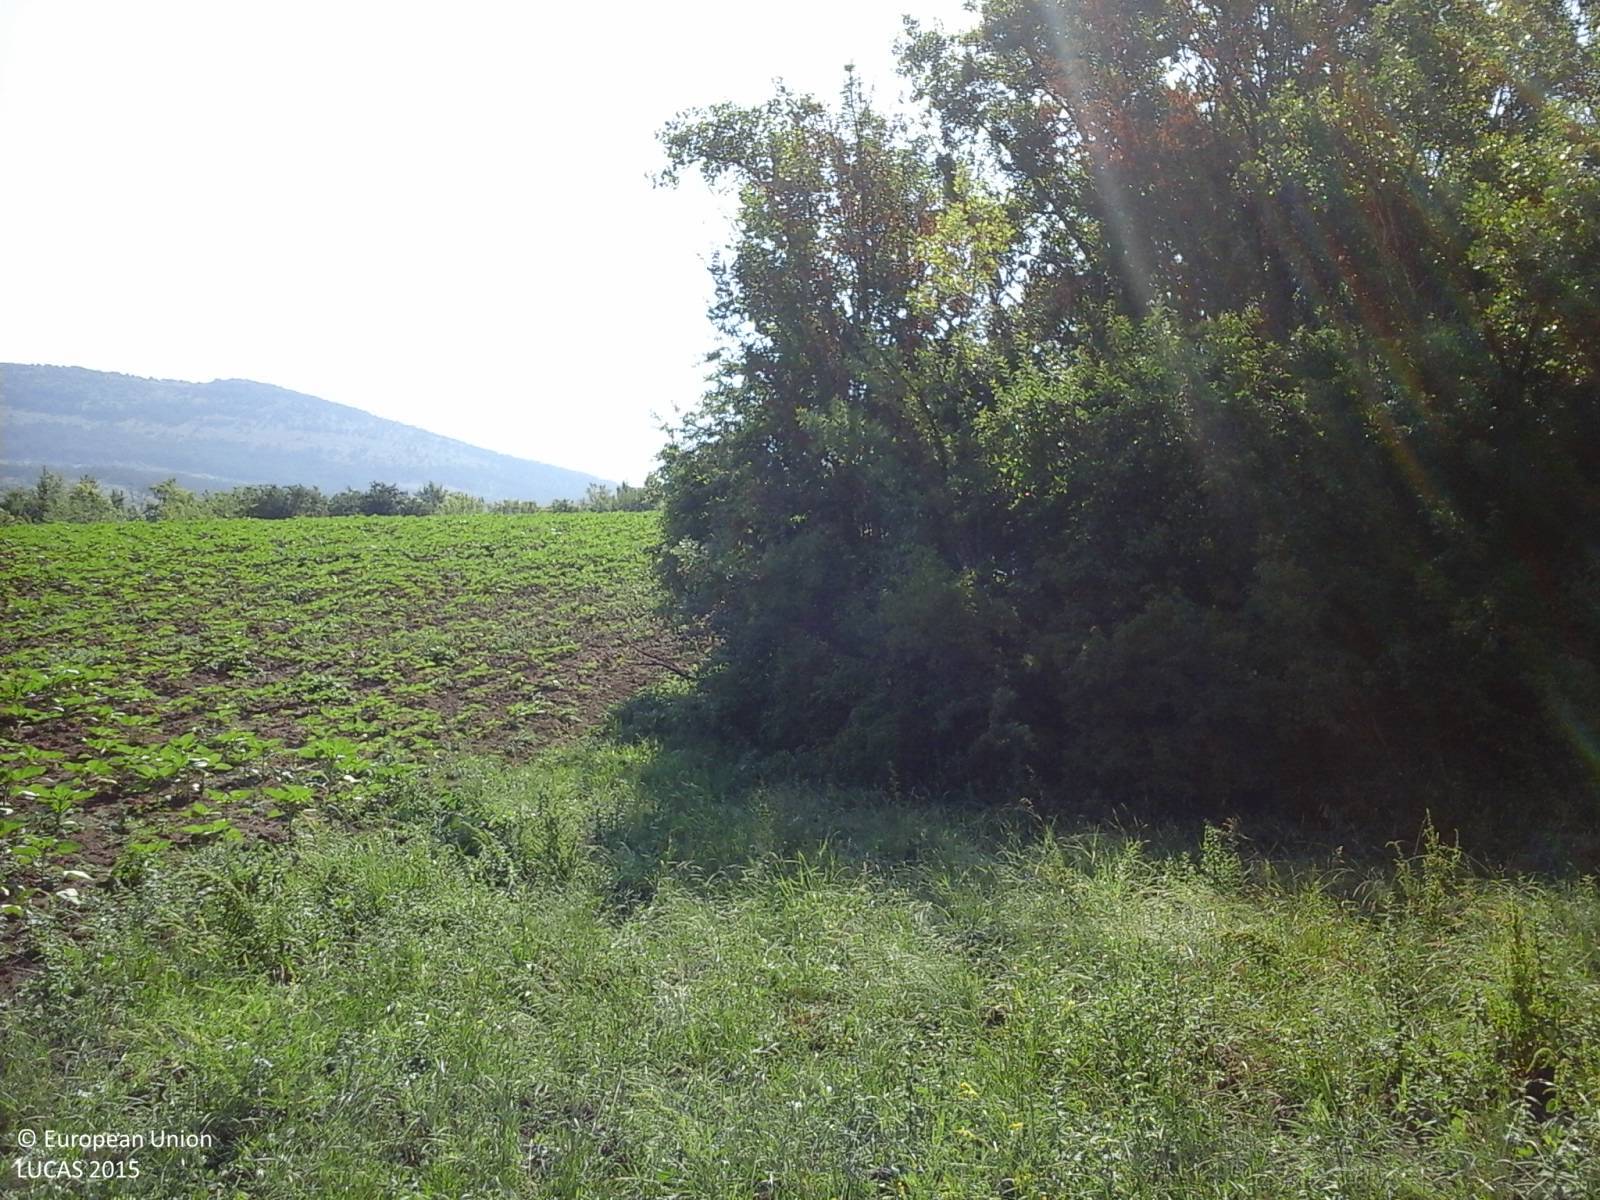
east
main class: Grassland
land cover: Spontaneously vegetated surfaces
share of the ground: > 75 %
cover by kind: herbaceous plants 100 %
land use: Fallow land
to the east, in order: Spontaneously vegetated surfaces; Sunflower; Grass margins; Shrubland with sparse tree cover; Grass margins; Paved roads, cycling and walking lanes; Grass margins; Lines of trees; Barley
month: June
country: IT
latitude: 42.0965
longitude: 13.7478
